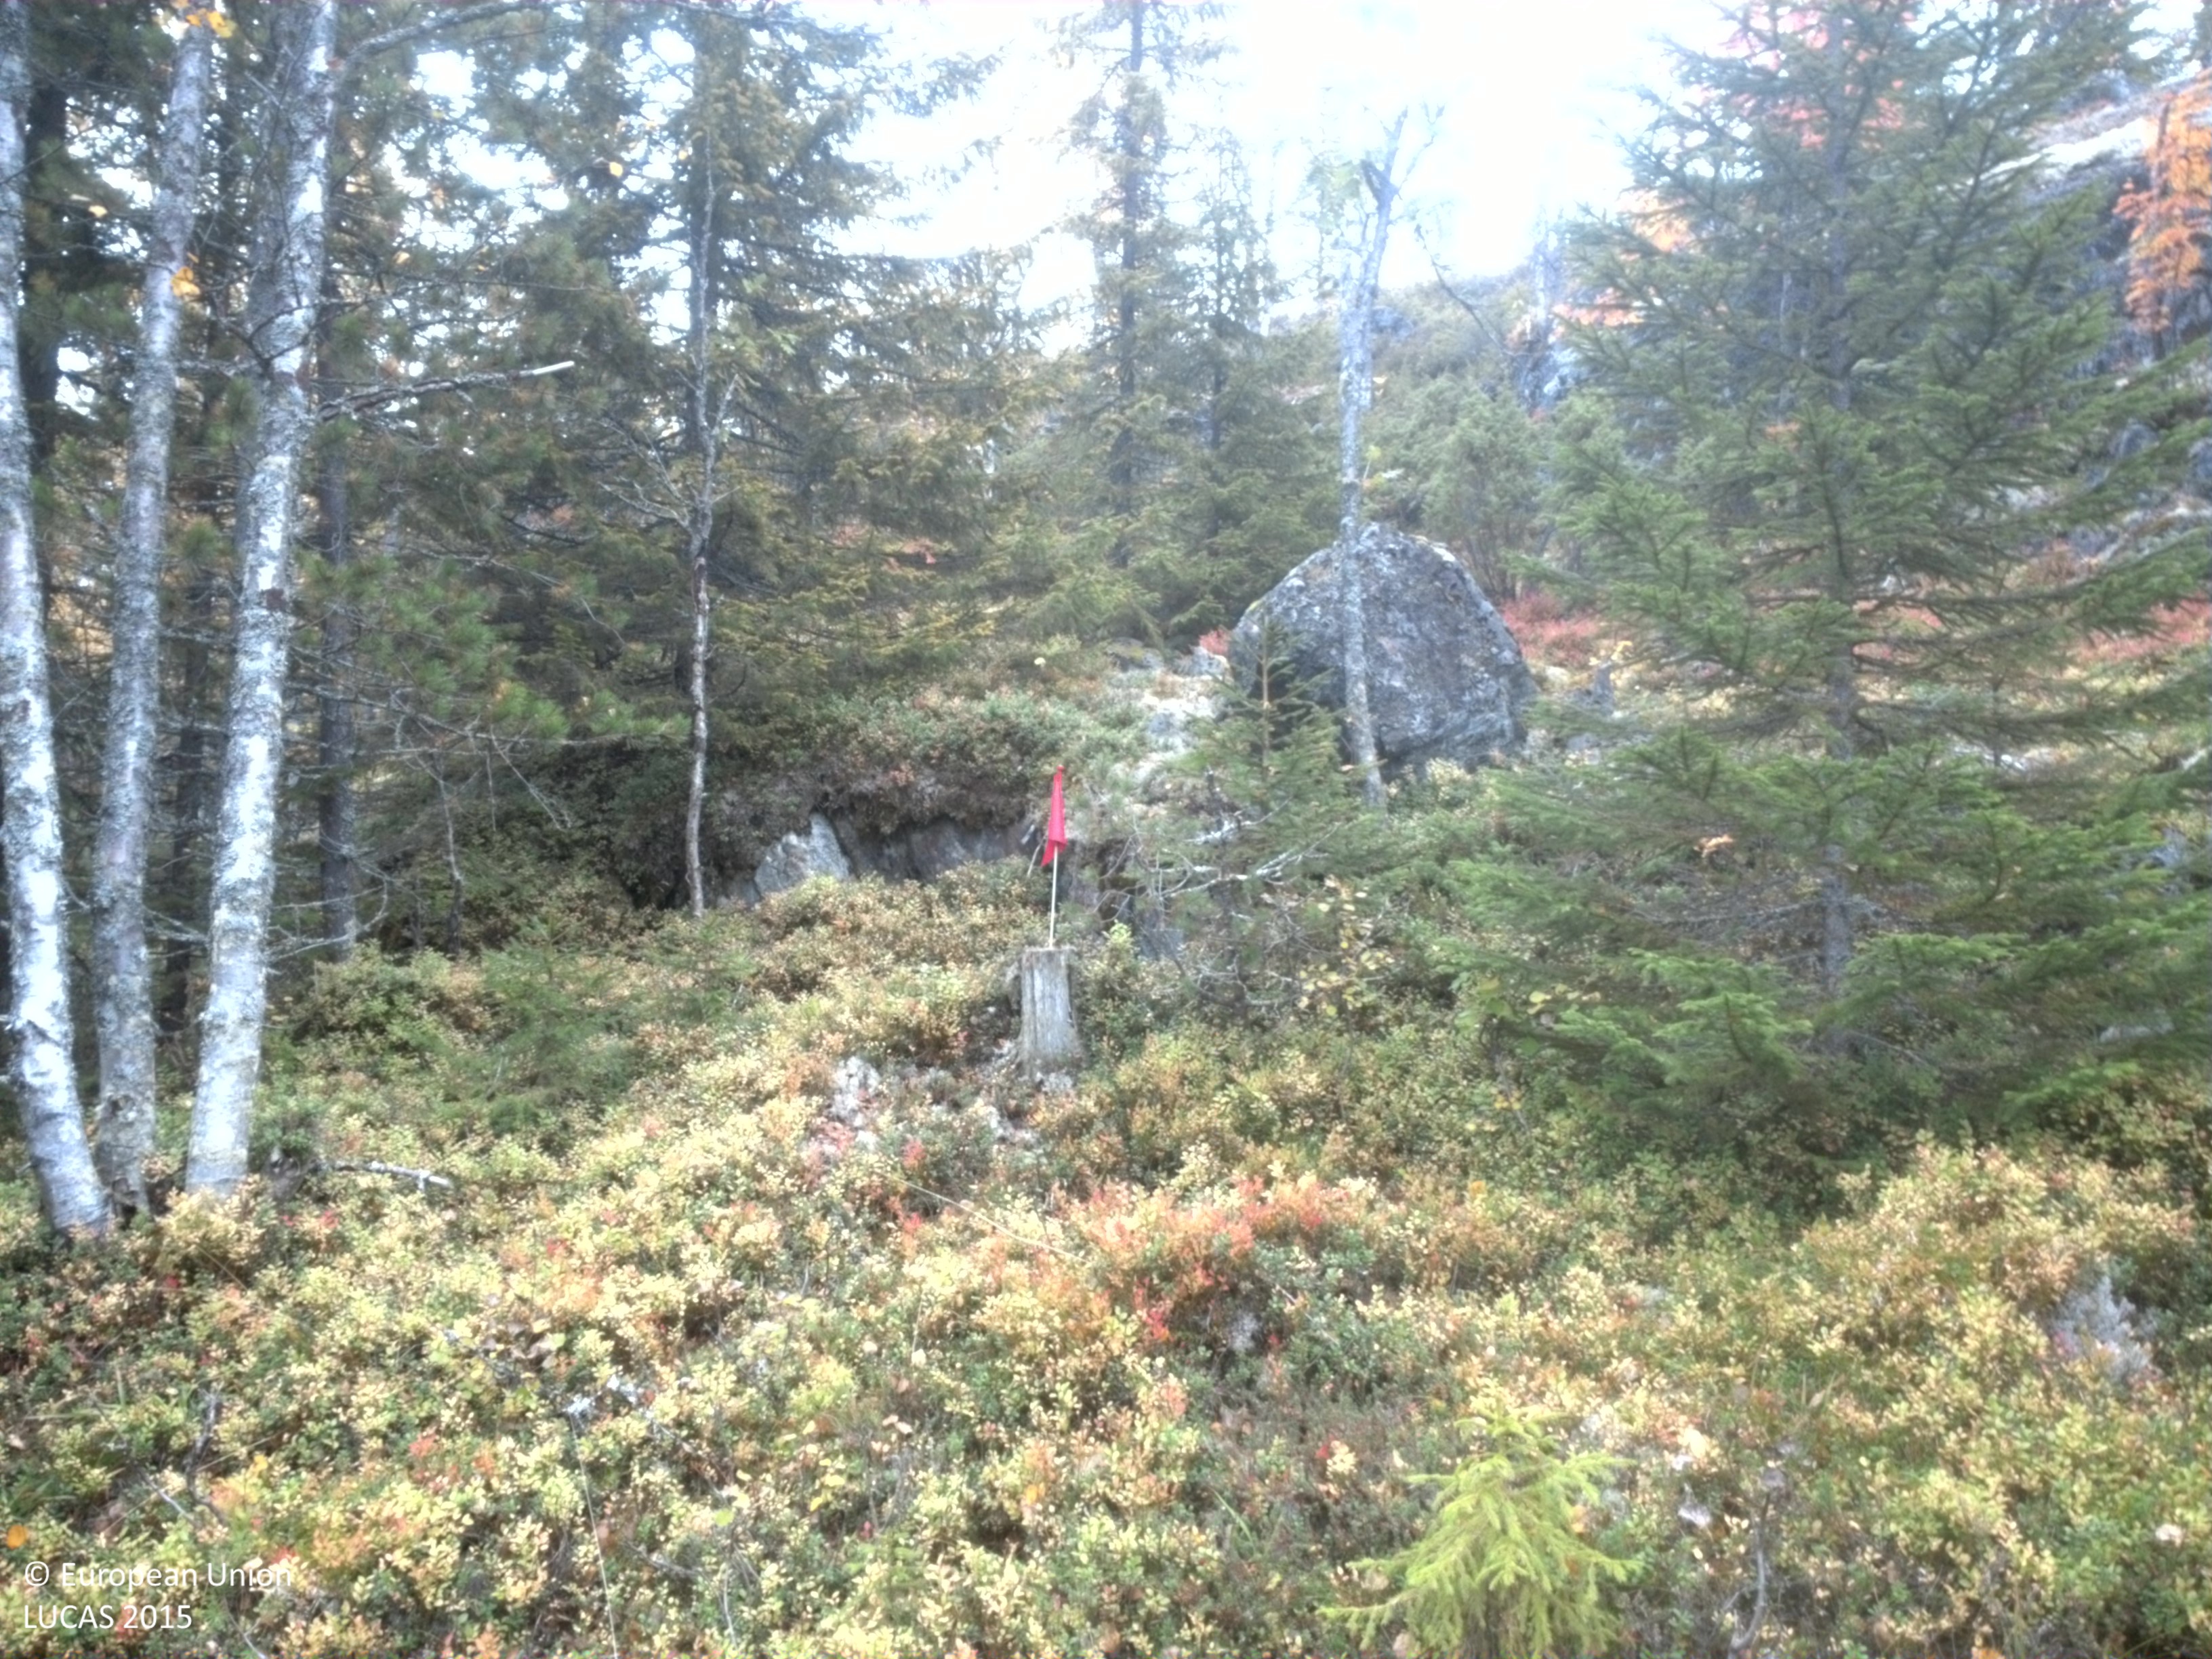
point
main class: Woodland
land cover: Other mixed woodland
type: boreal forest
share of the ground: 50 - 75 %
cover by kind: coniferous forest trees 40 %, shrubs 40 %, broadleaved forest trees 20 %
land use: Forestry
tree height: > 5 m
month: September
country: SE
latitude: 64.2624
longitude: 20.0279
